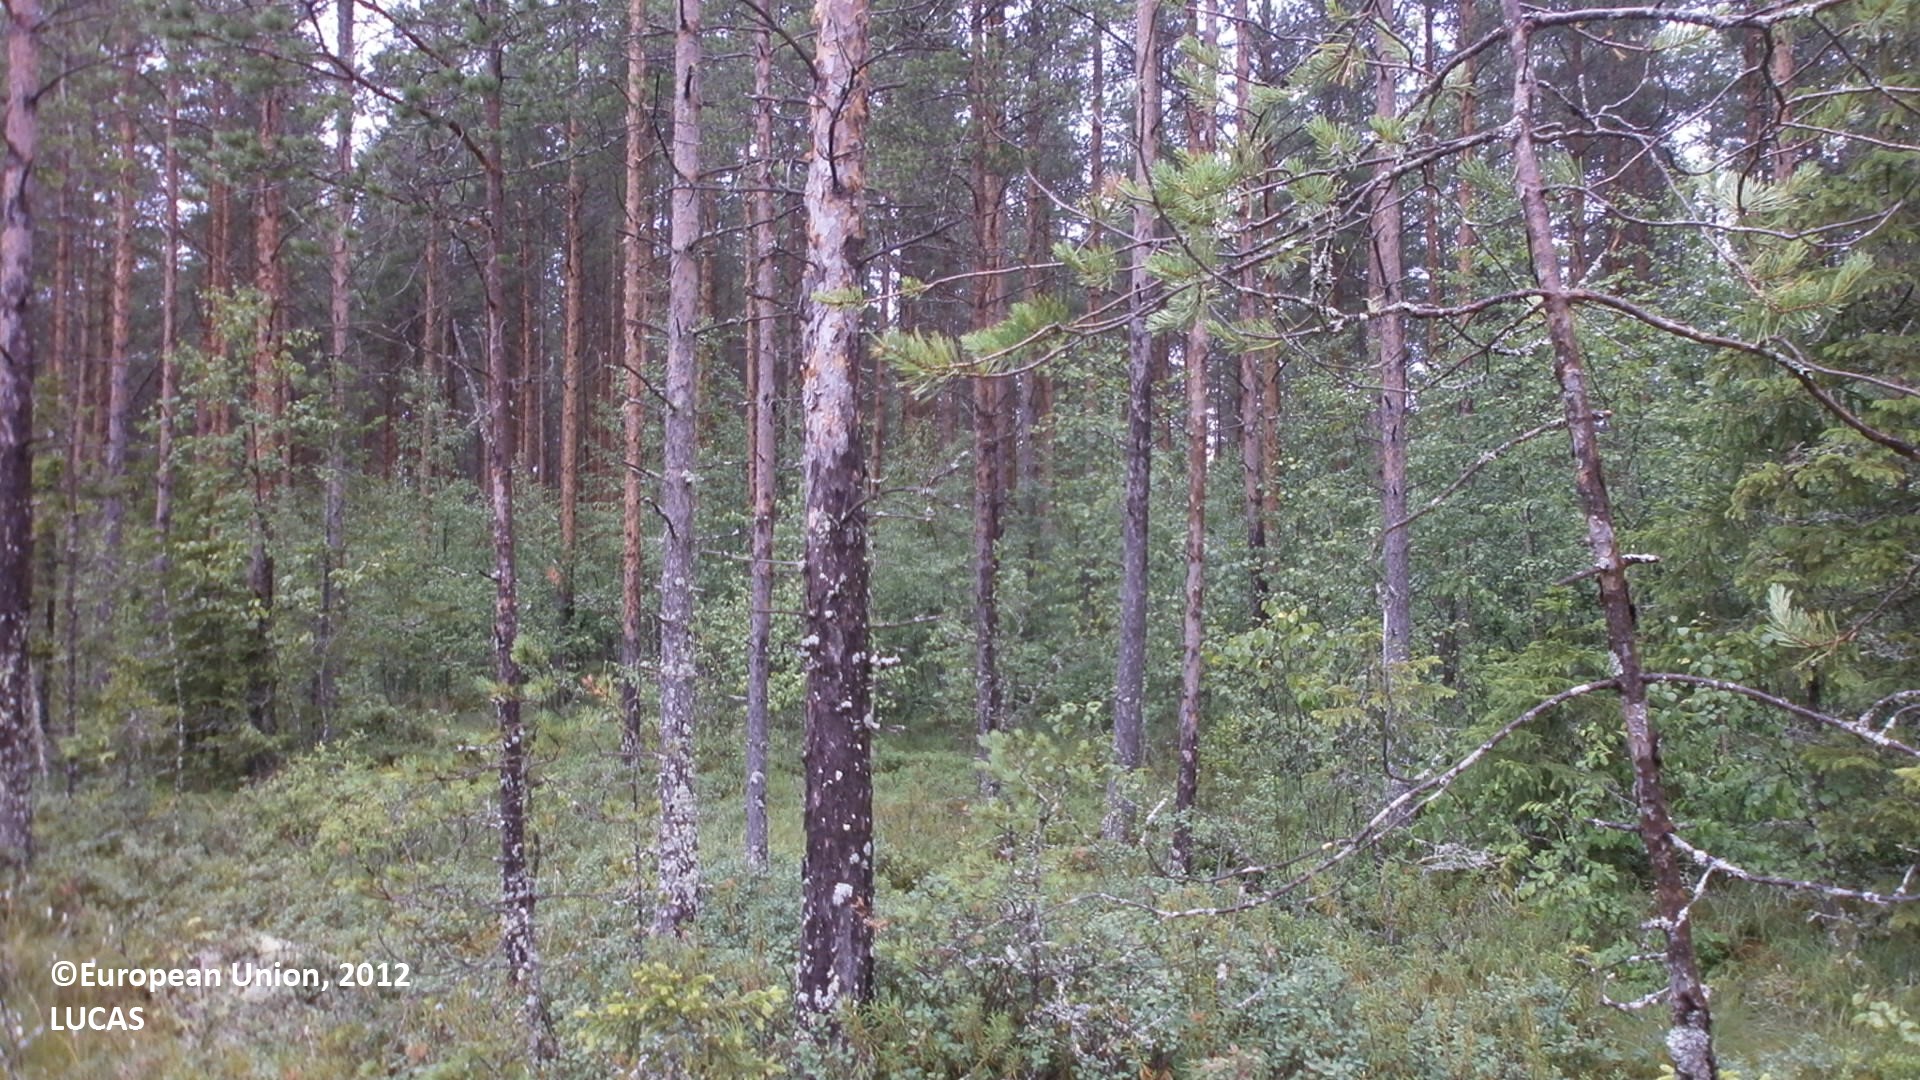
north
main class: Woodland
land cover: Pine dominated coniferous woodland
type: mire and swamp forests
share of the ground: 50 - 75 %
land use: Forestry
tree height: > 5 m
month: July
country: FI
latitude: 64.0733
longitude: 23.7333
